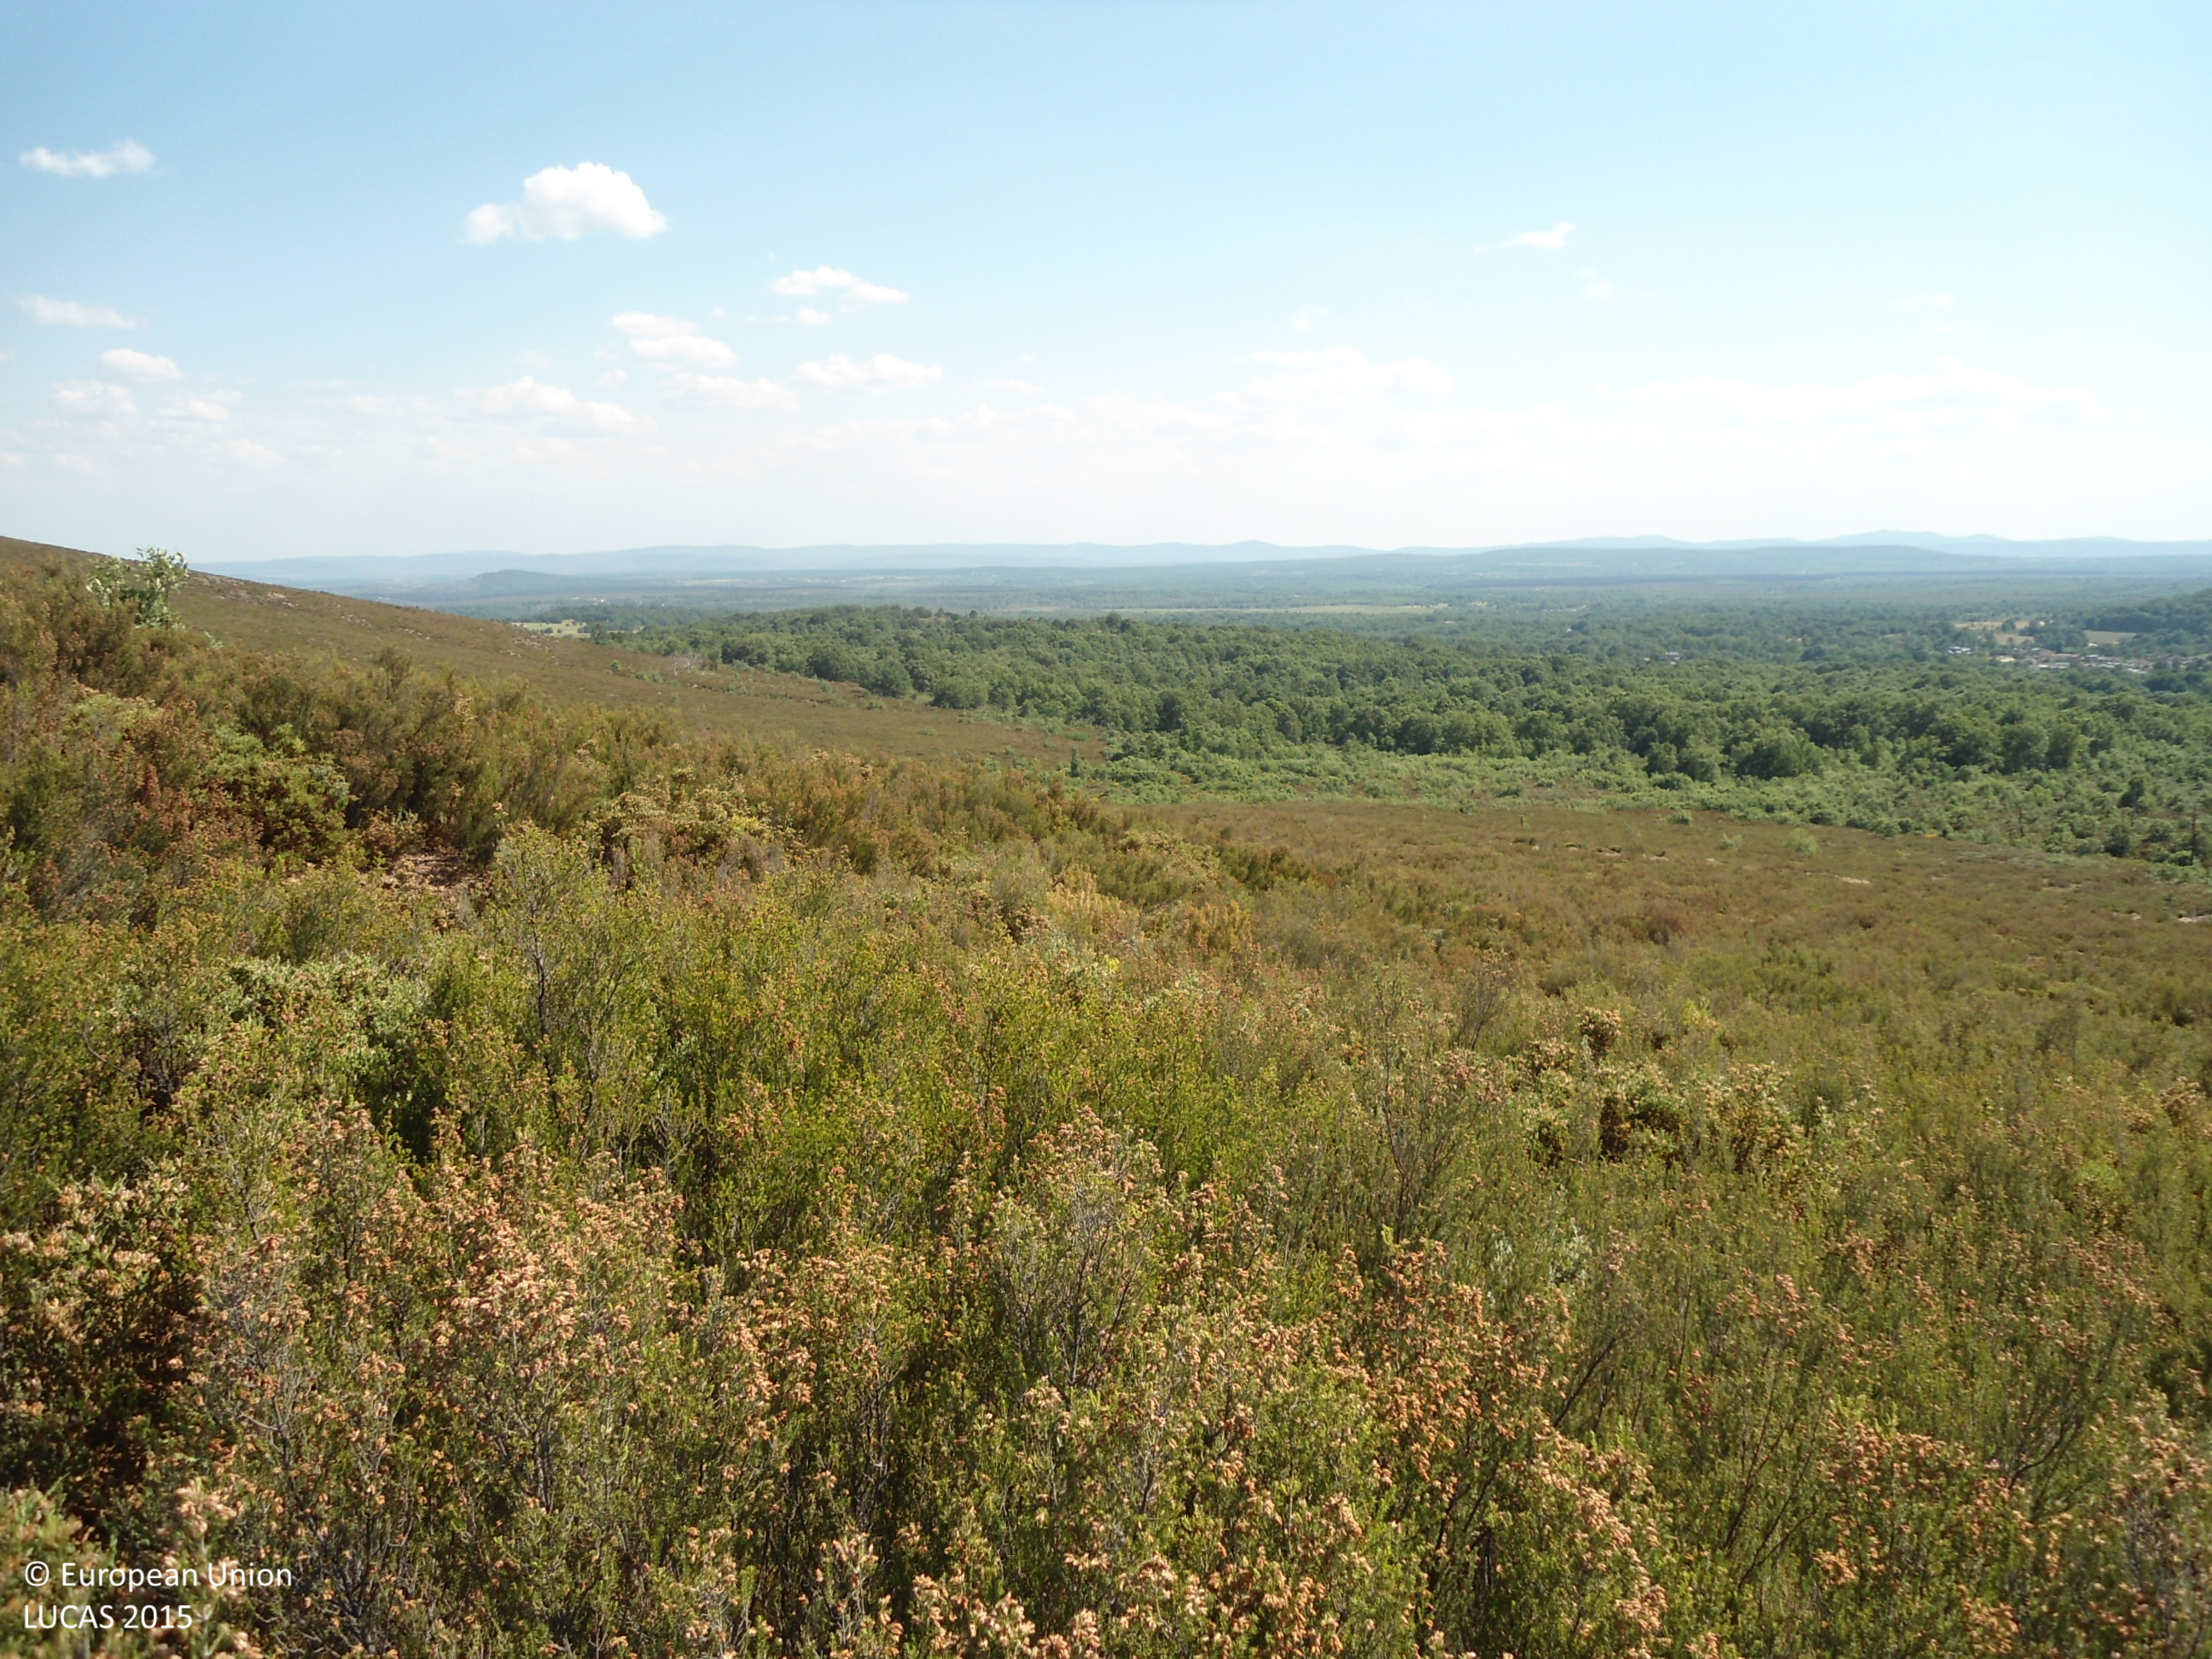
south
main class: Shrubland
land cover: Shrubland without tree cover
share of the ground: > 75 %
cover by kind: shrubs 100 %
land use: Semi-natural and natural areas not in use
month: June
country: ES
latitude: 42.1410
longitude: -6.3582
